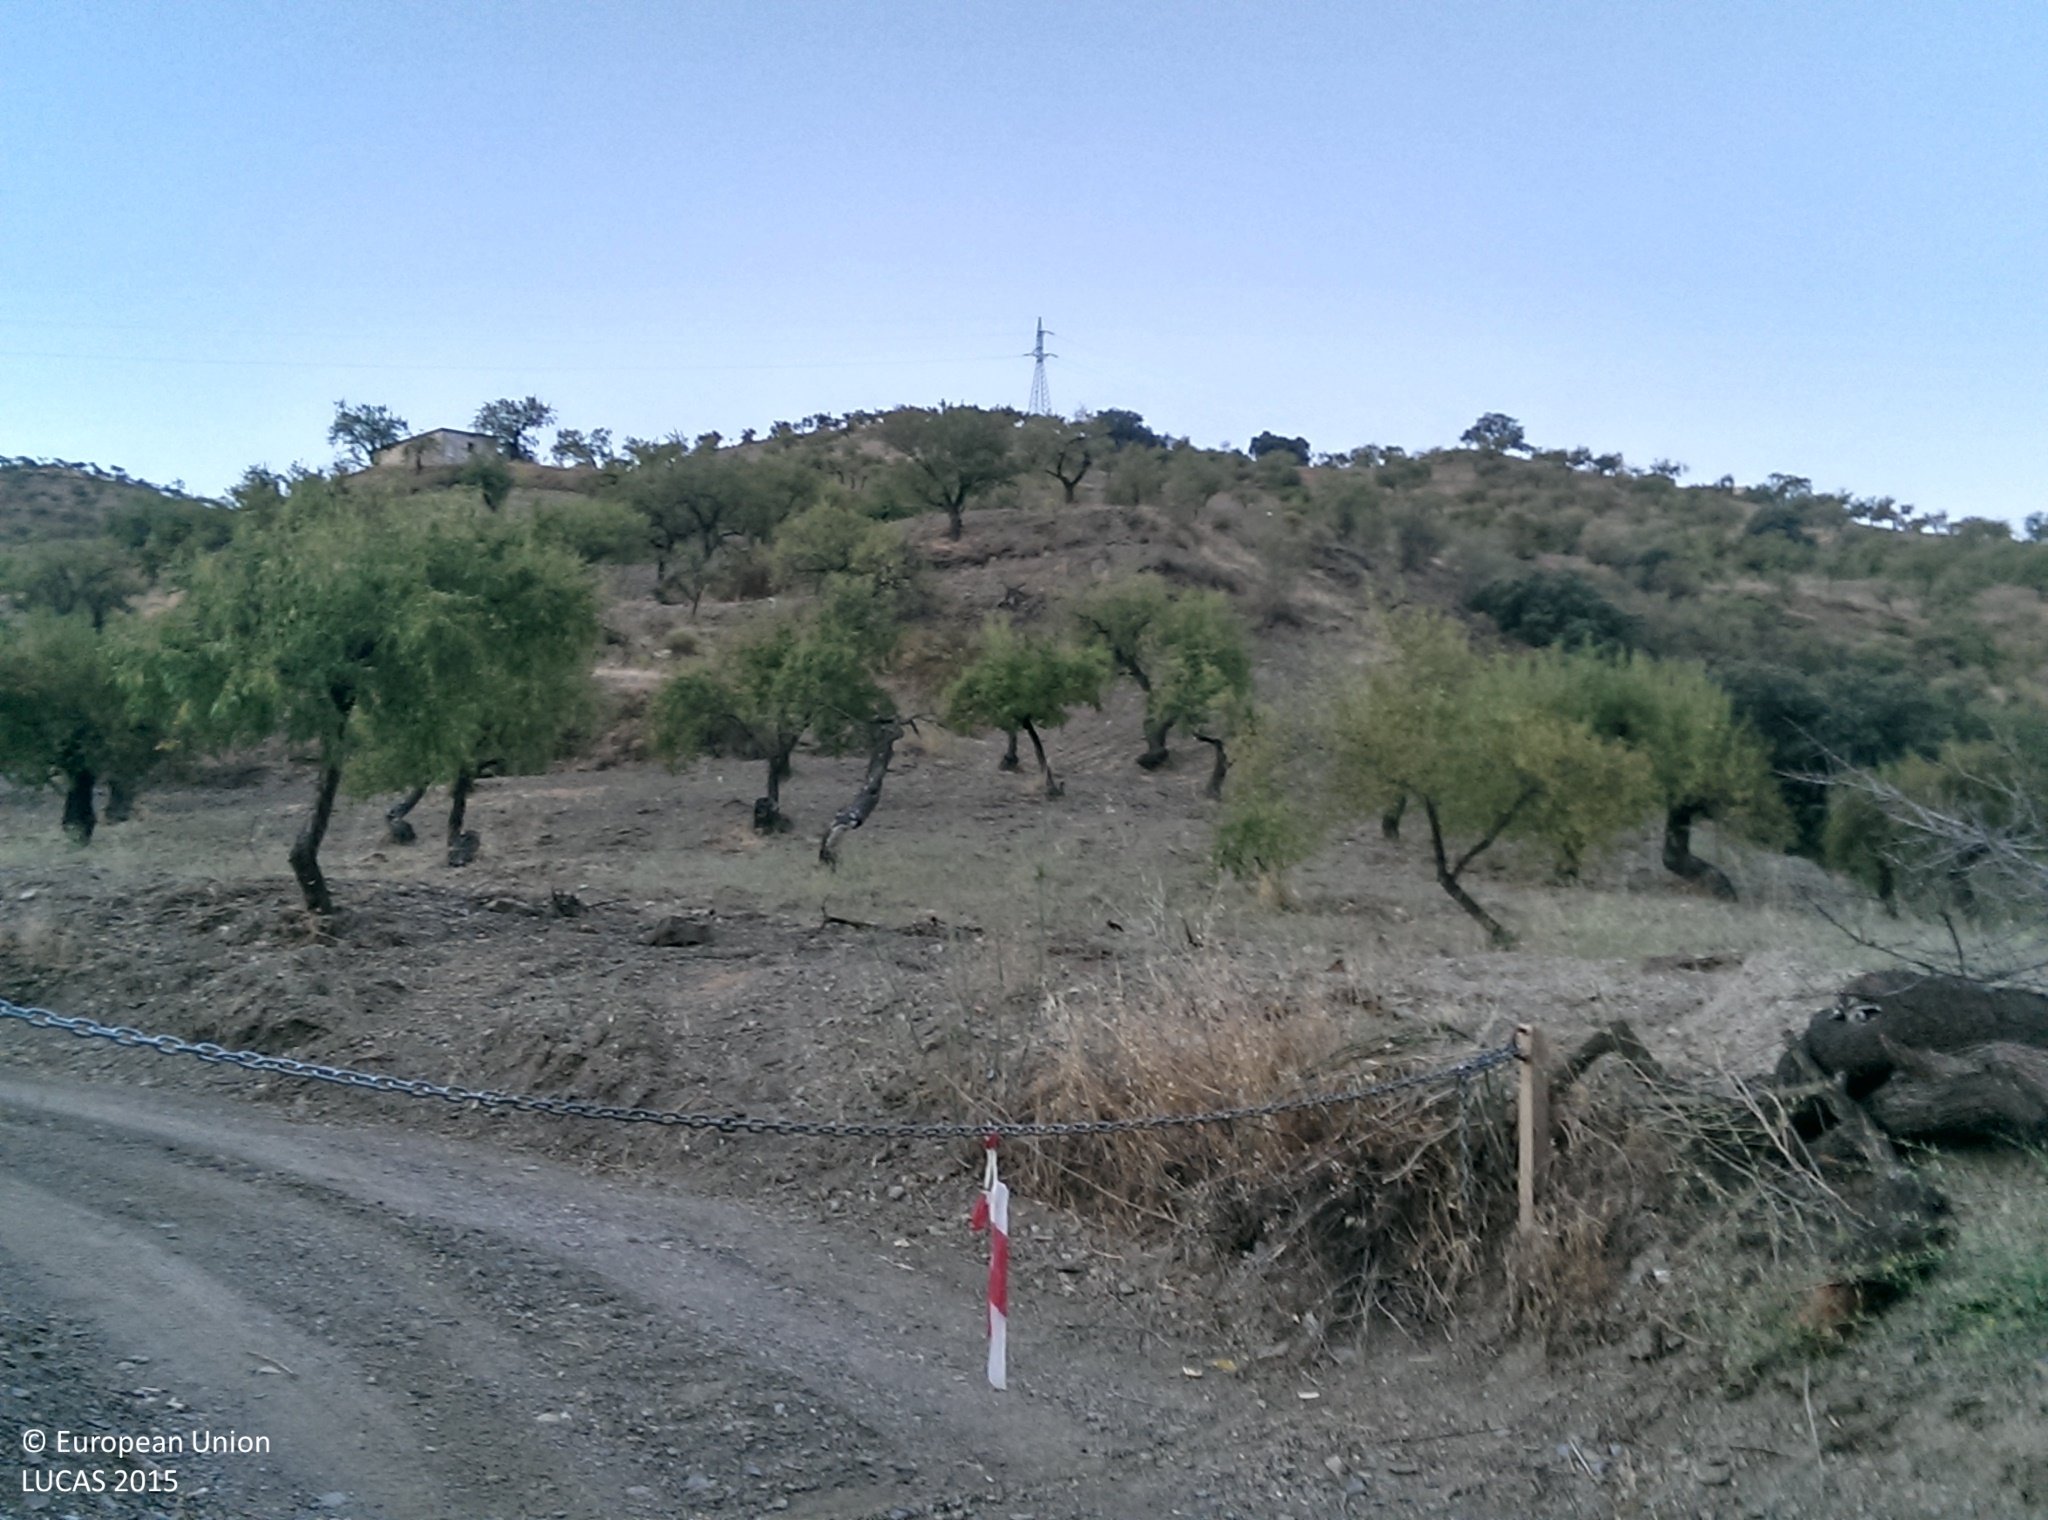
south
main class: Cropland
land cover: Nuts trees
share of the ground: 10 - 25 %
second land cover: Other bare soil
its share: > 75 %
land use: Agriculture (excluding fallow land and kitchen gardens)
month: August
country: ES
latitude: 36.9158
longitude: -3.1929
